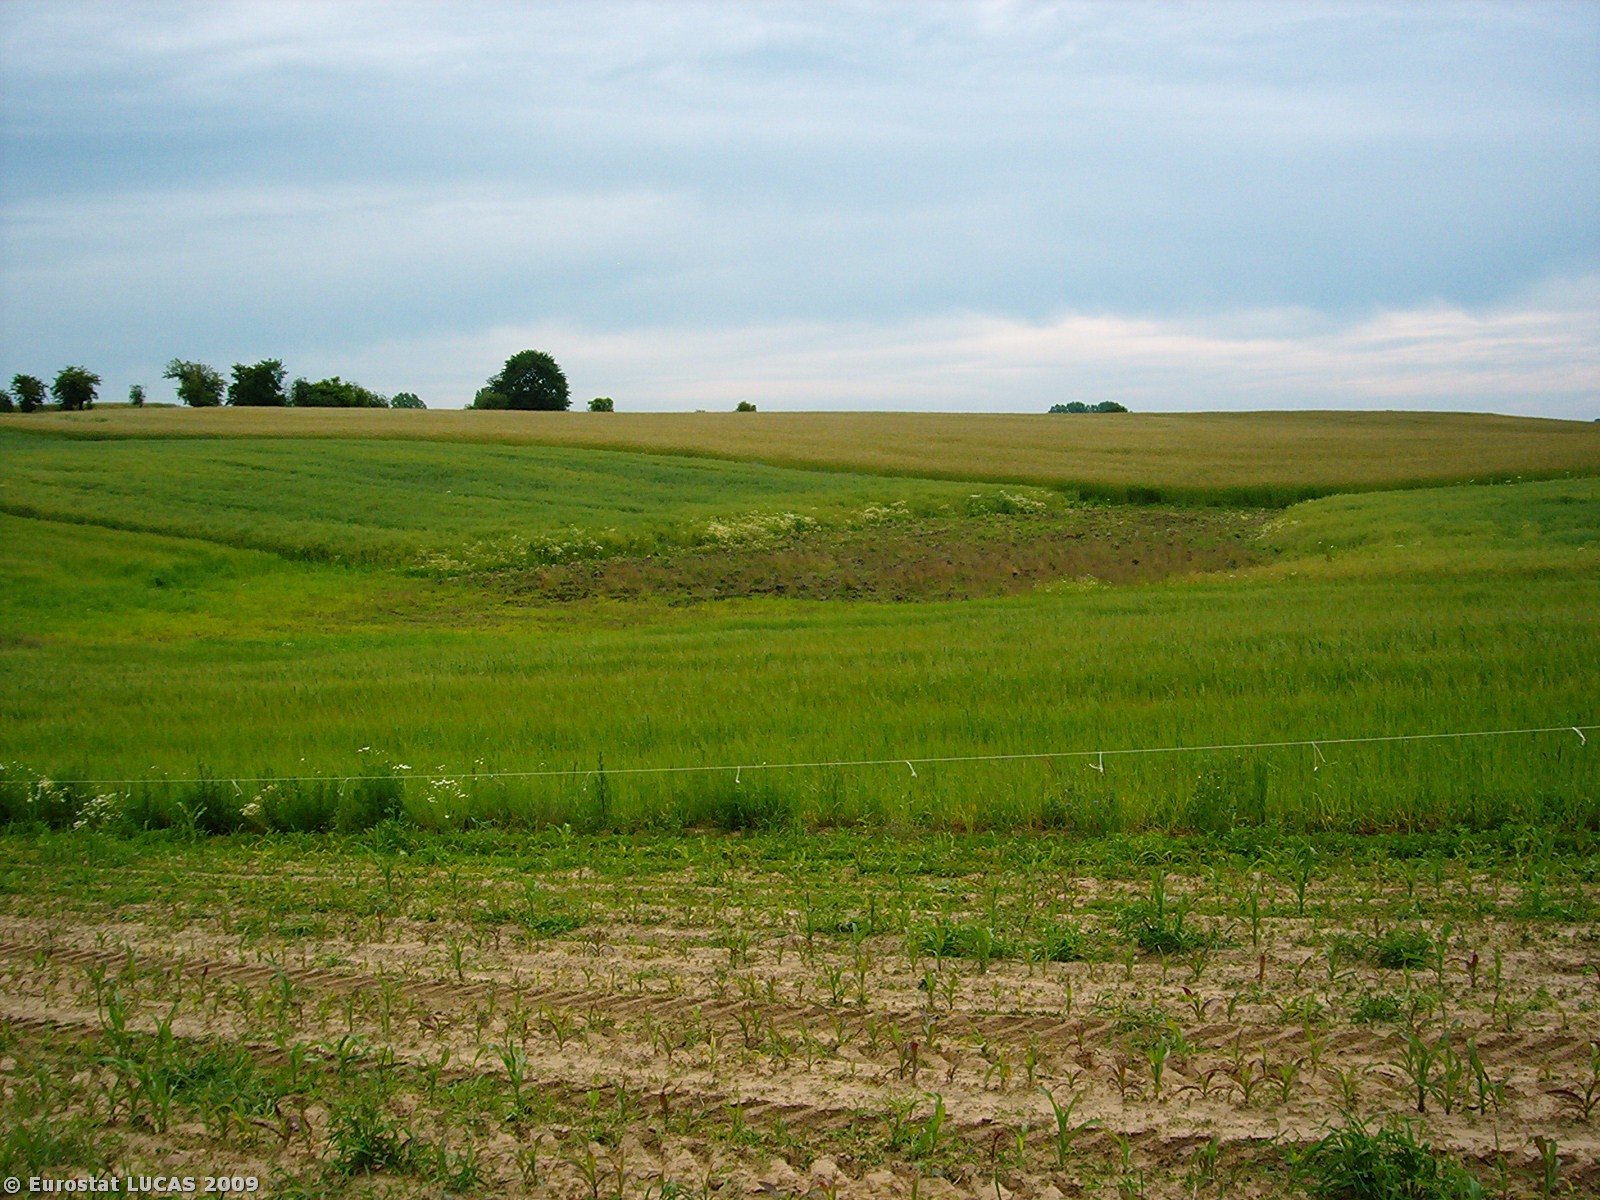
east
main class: Cropland
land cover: Maize
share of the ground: 10 - 25 %
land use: Agriculture (excluding fallow land and kitchen gardens)
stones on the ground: < 10 %
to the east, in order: Maize; Barley; Rape and turnip rape; Rye
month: June
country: PL
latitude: 53.0989
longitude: 15.4547
